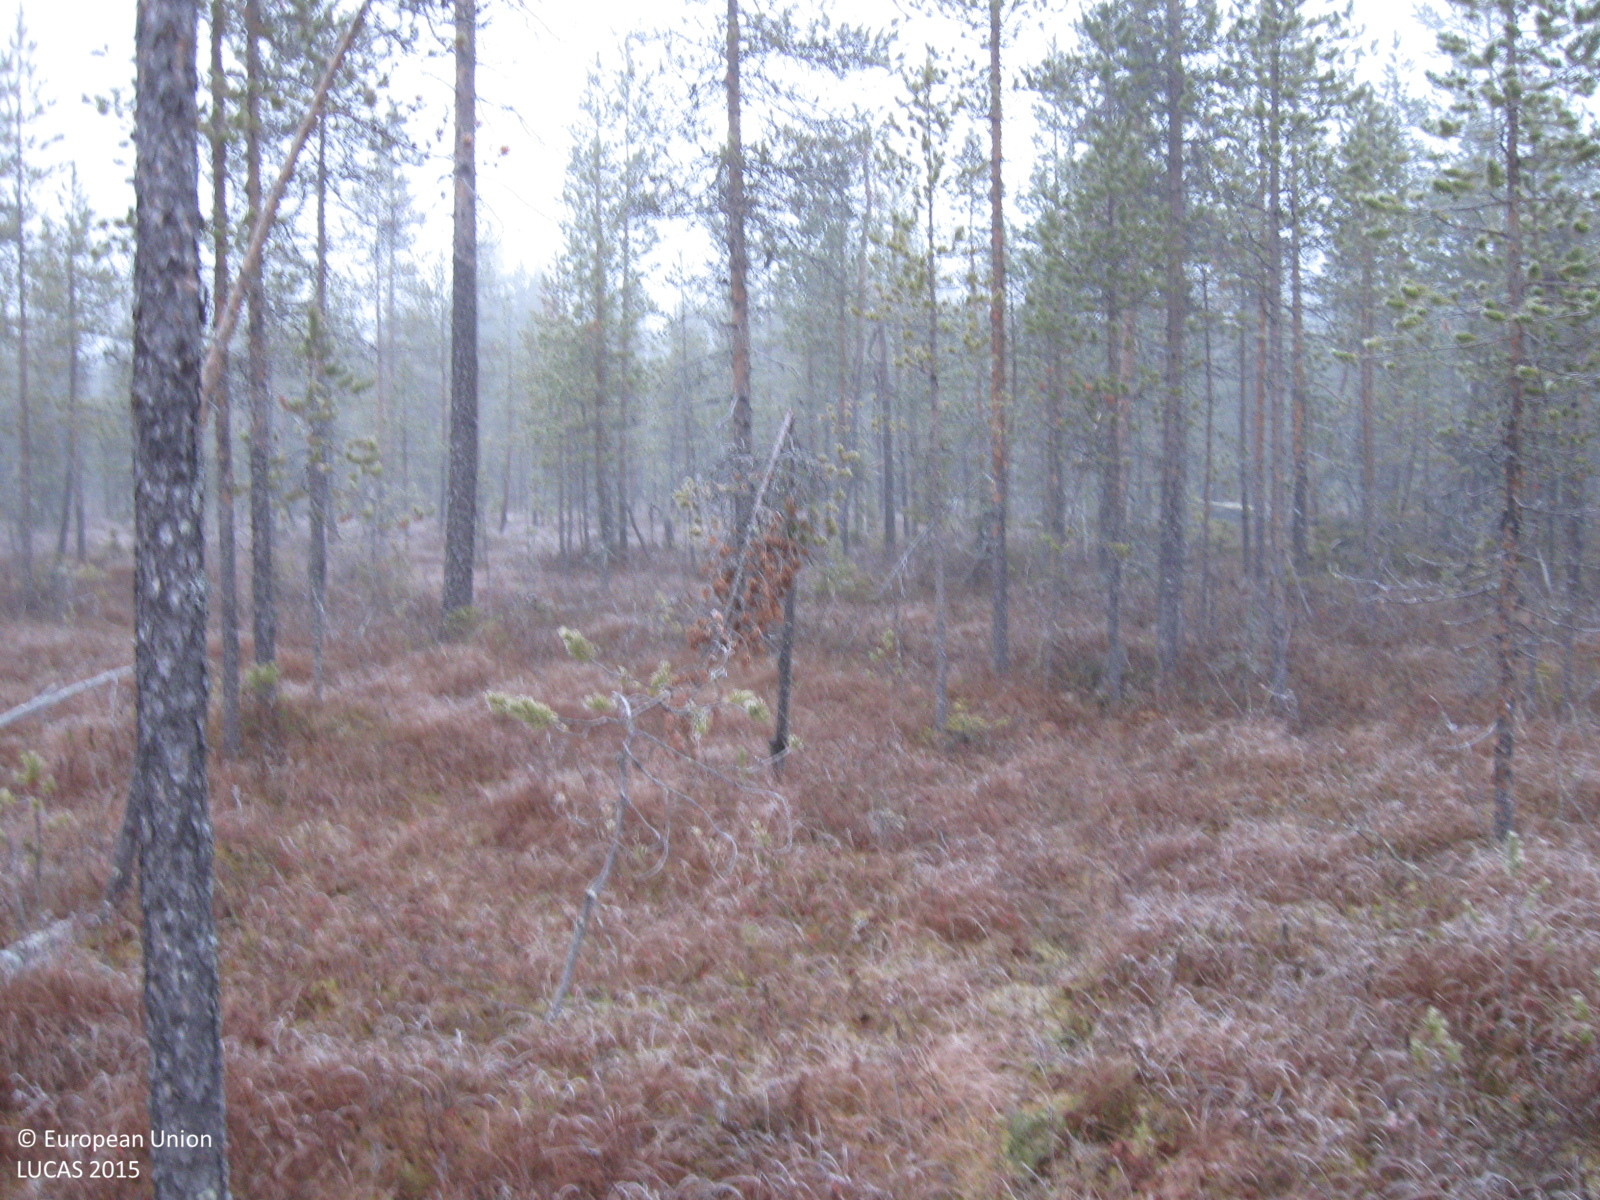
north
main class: Woodland
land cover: Pine dominated coniferous woodland
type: mire and swamp forests
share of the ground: 10 - 25 %
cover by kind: herbaceous plants 45 %, lichens and mosses 30 %, coniferous forest trees 15 %, shrubs 10 %
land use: Forestry
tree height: > 5 m
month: October
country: SE
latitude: 66.3960
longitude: 21.7606
